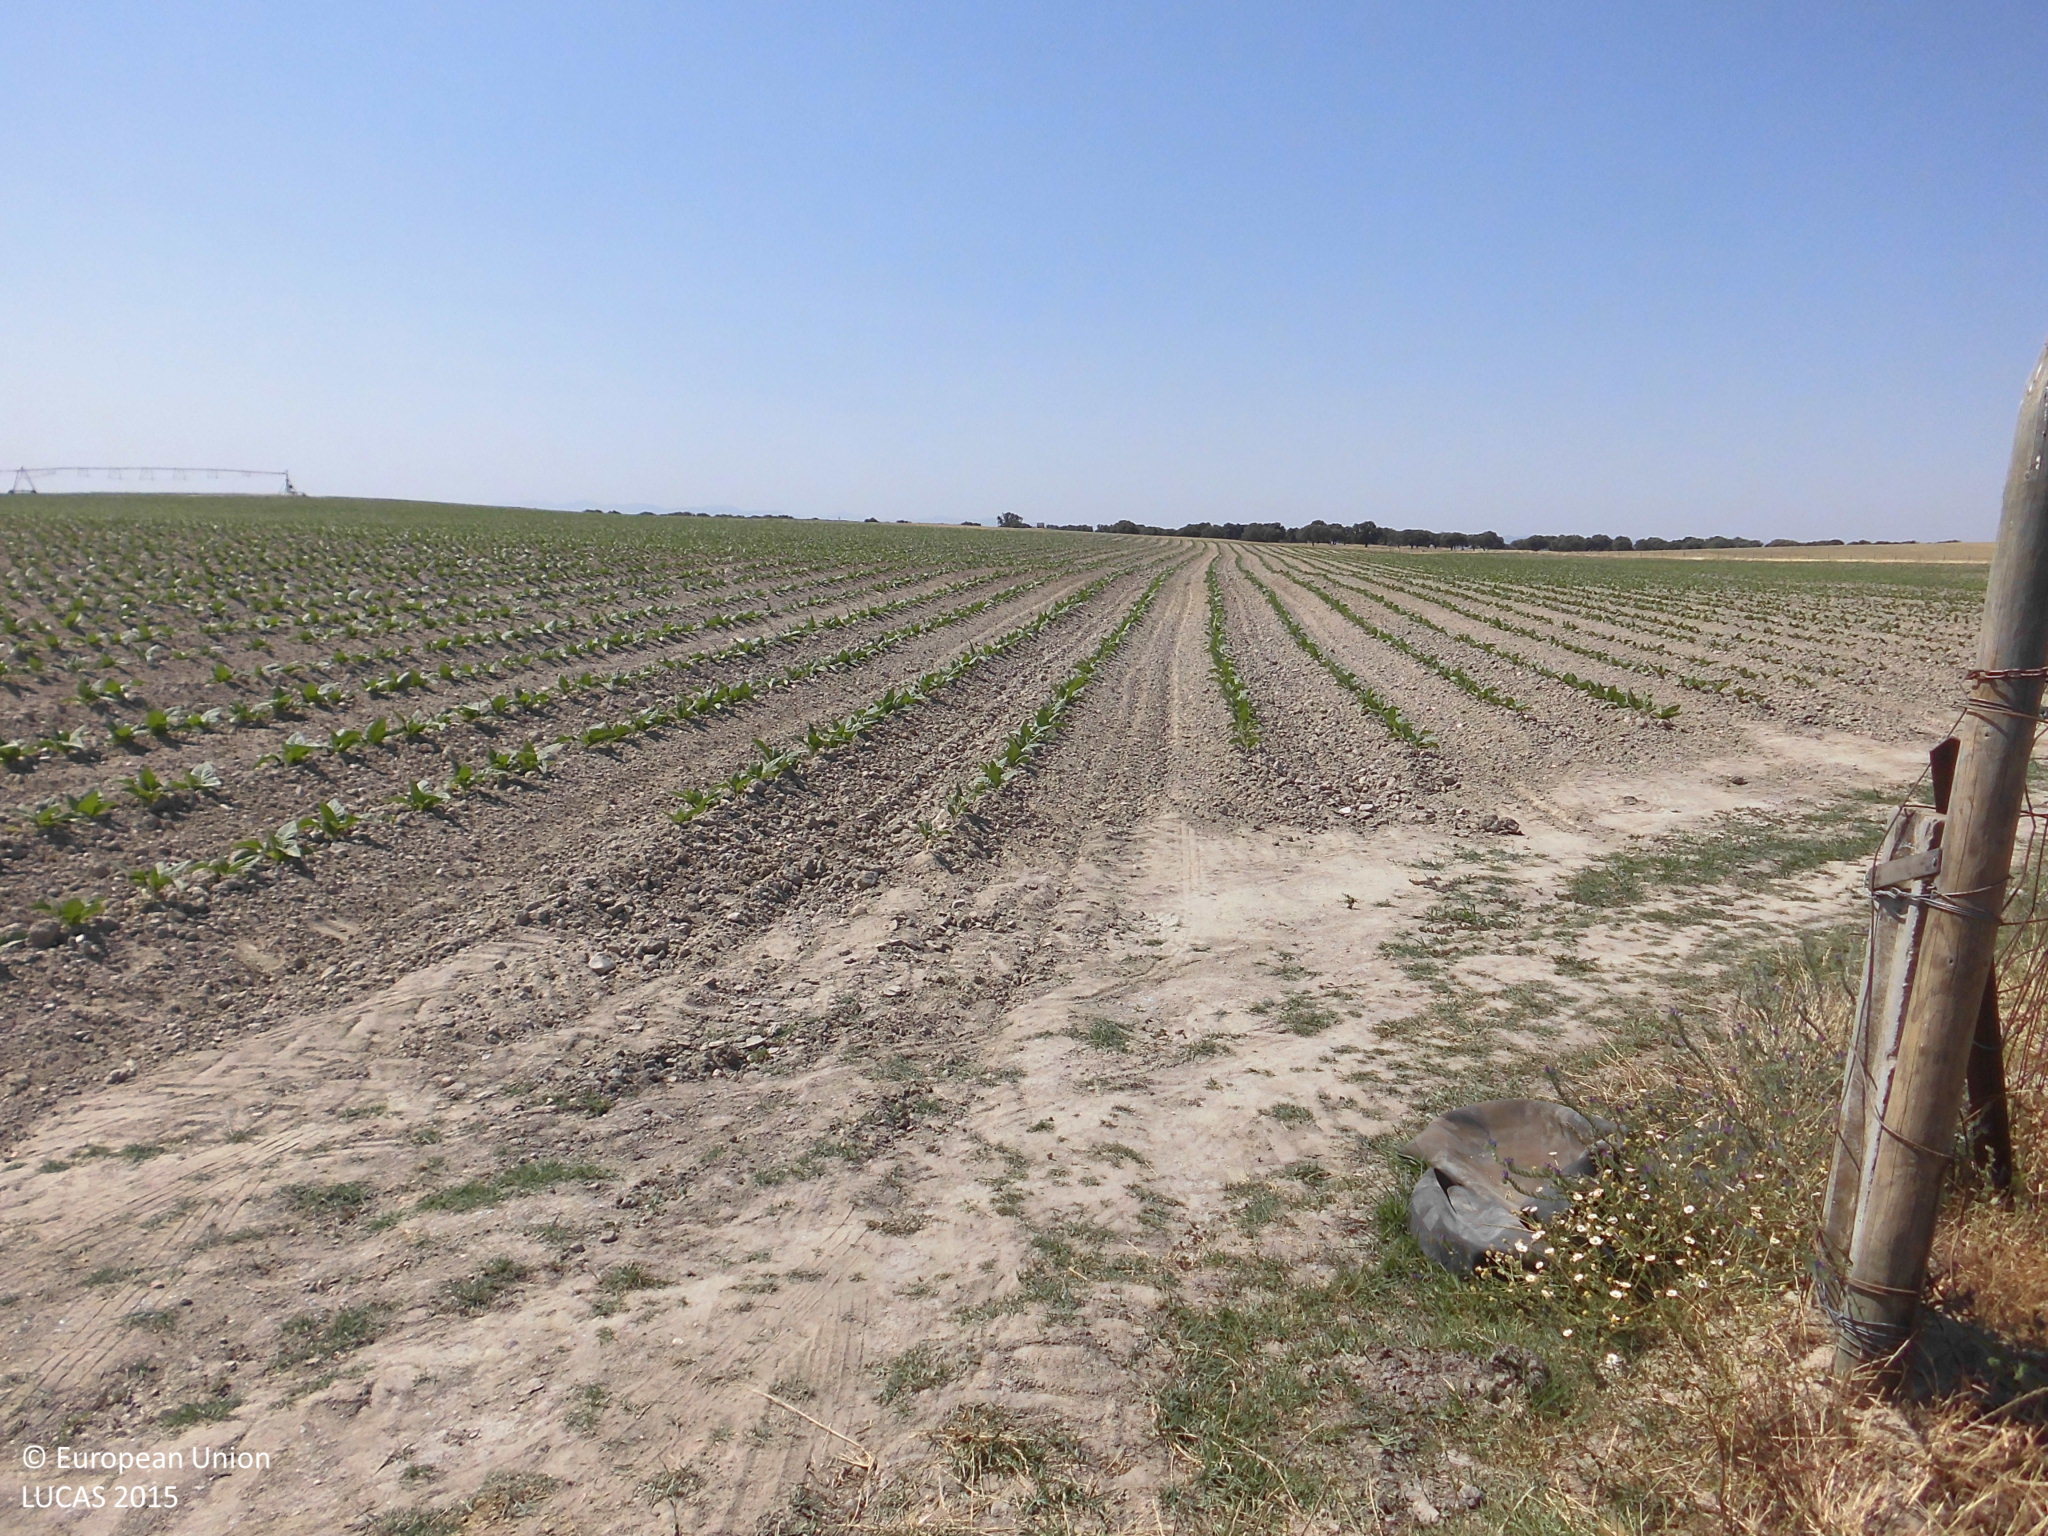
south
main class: Woodland
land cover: Broadleaved woodland
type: broadleaved evergreen forest
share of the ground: 10 - 25 %
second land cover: Grassland without tree/shrub cover
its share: > 75 %
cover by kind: herbaceous plants 85 %, broadleaved forest trees 10 %, unconsolidated bare surface 5 %
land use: Forestry
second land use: Agriculture (excluding fallow land and kitchen gardens)
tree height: > 5 m
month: June
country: ES
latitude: 40.0035
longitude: -5.4868
